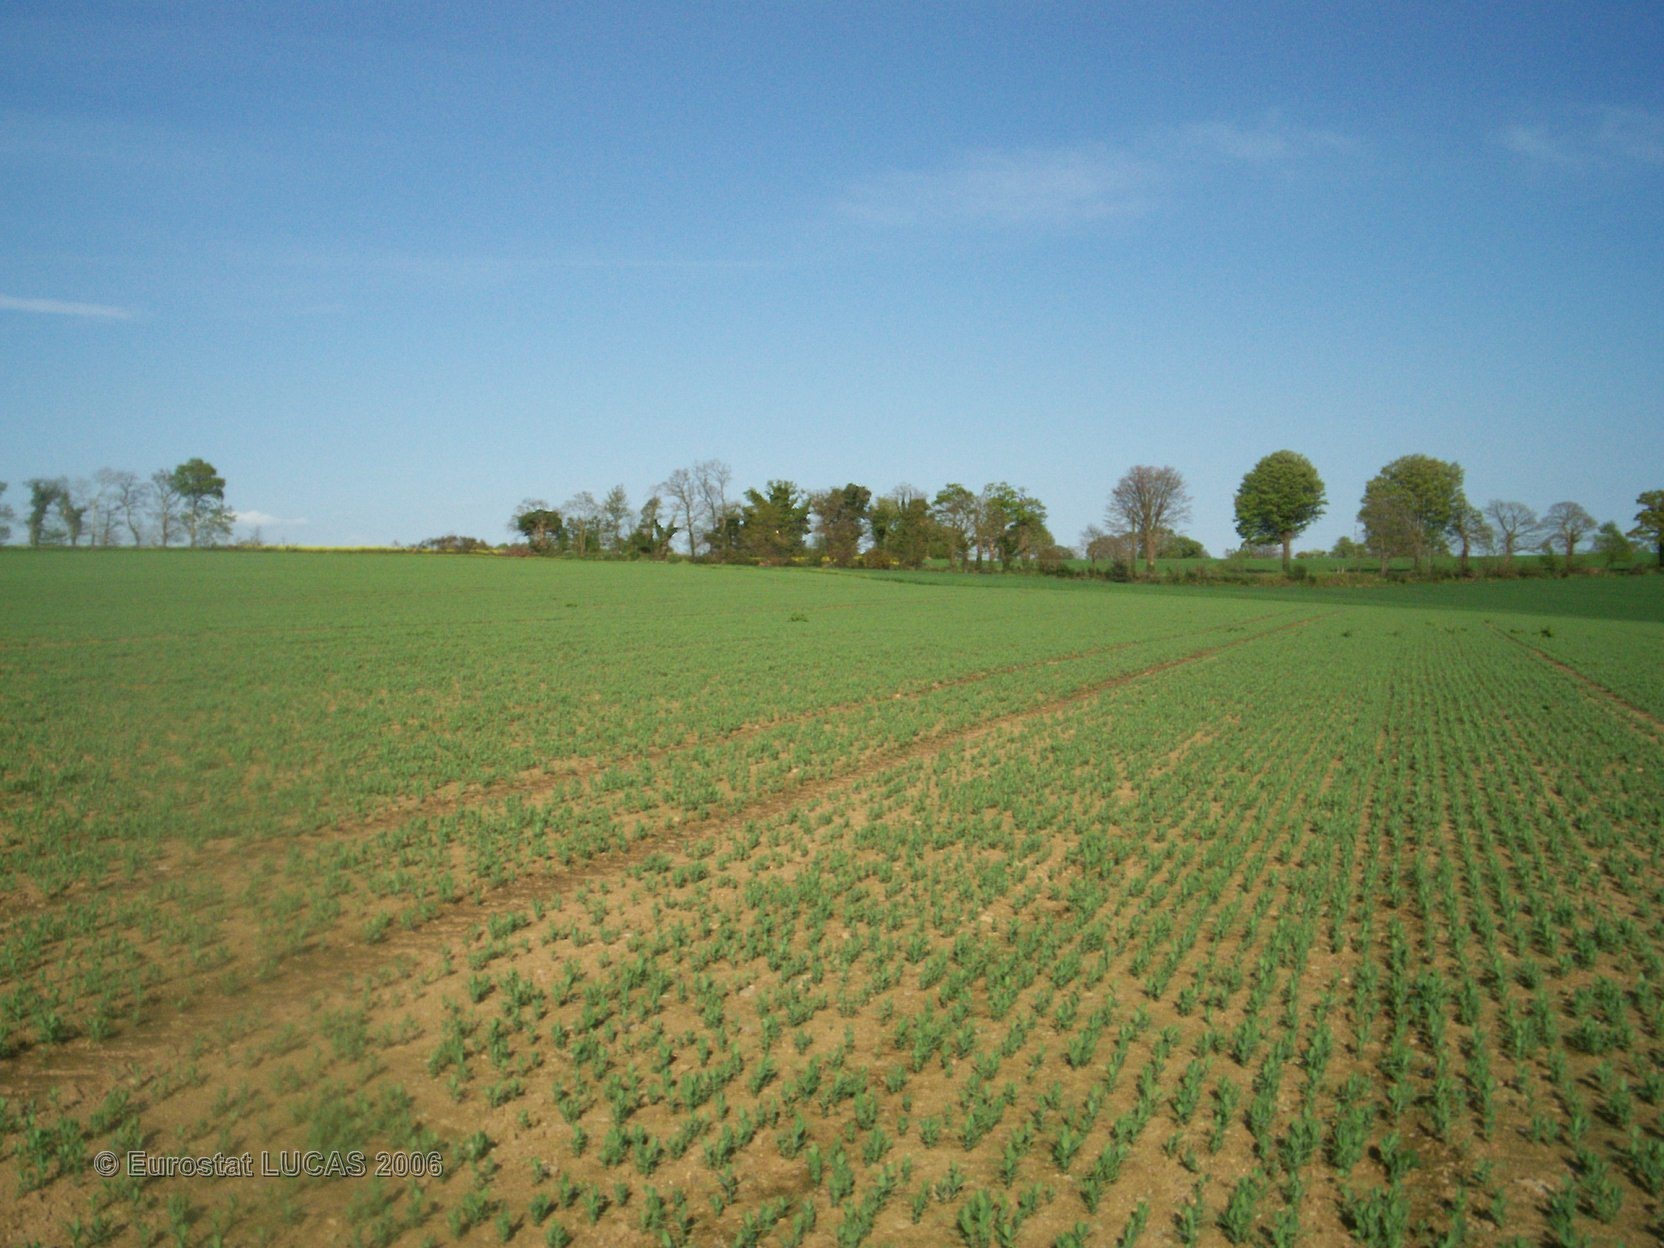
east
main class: Cropland
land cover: Dry pulses
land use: Agriculture (excluding fallow land and kitchen gardens)
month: May
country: FR
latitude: 47.9706
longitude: -2.9119
